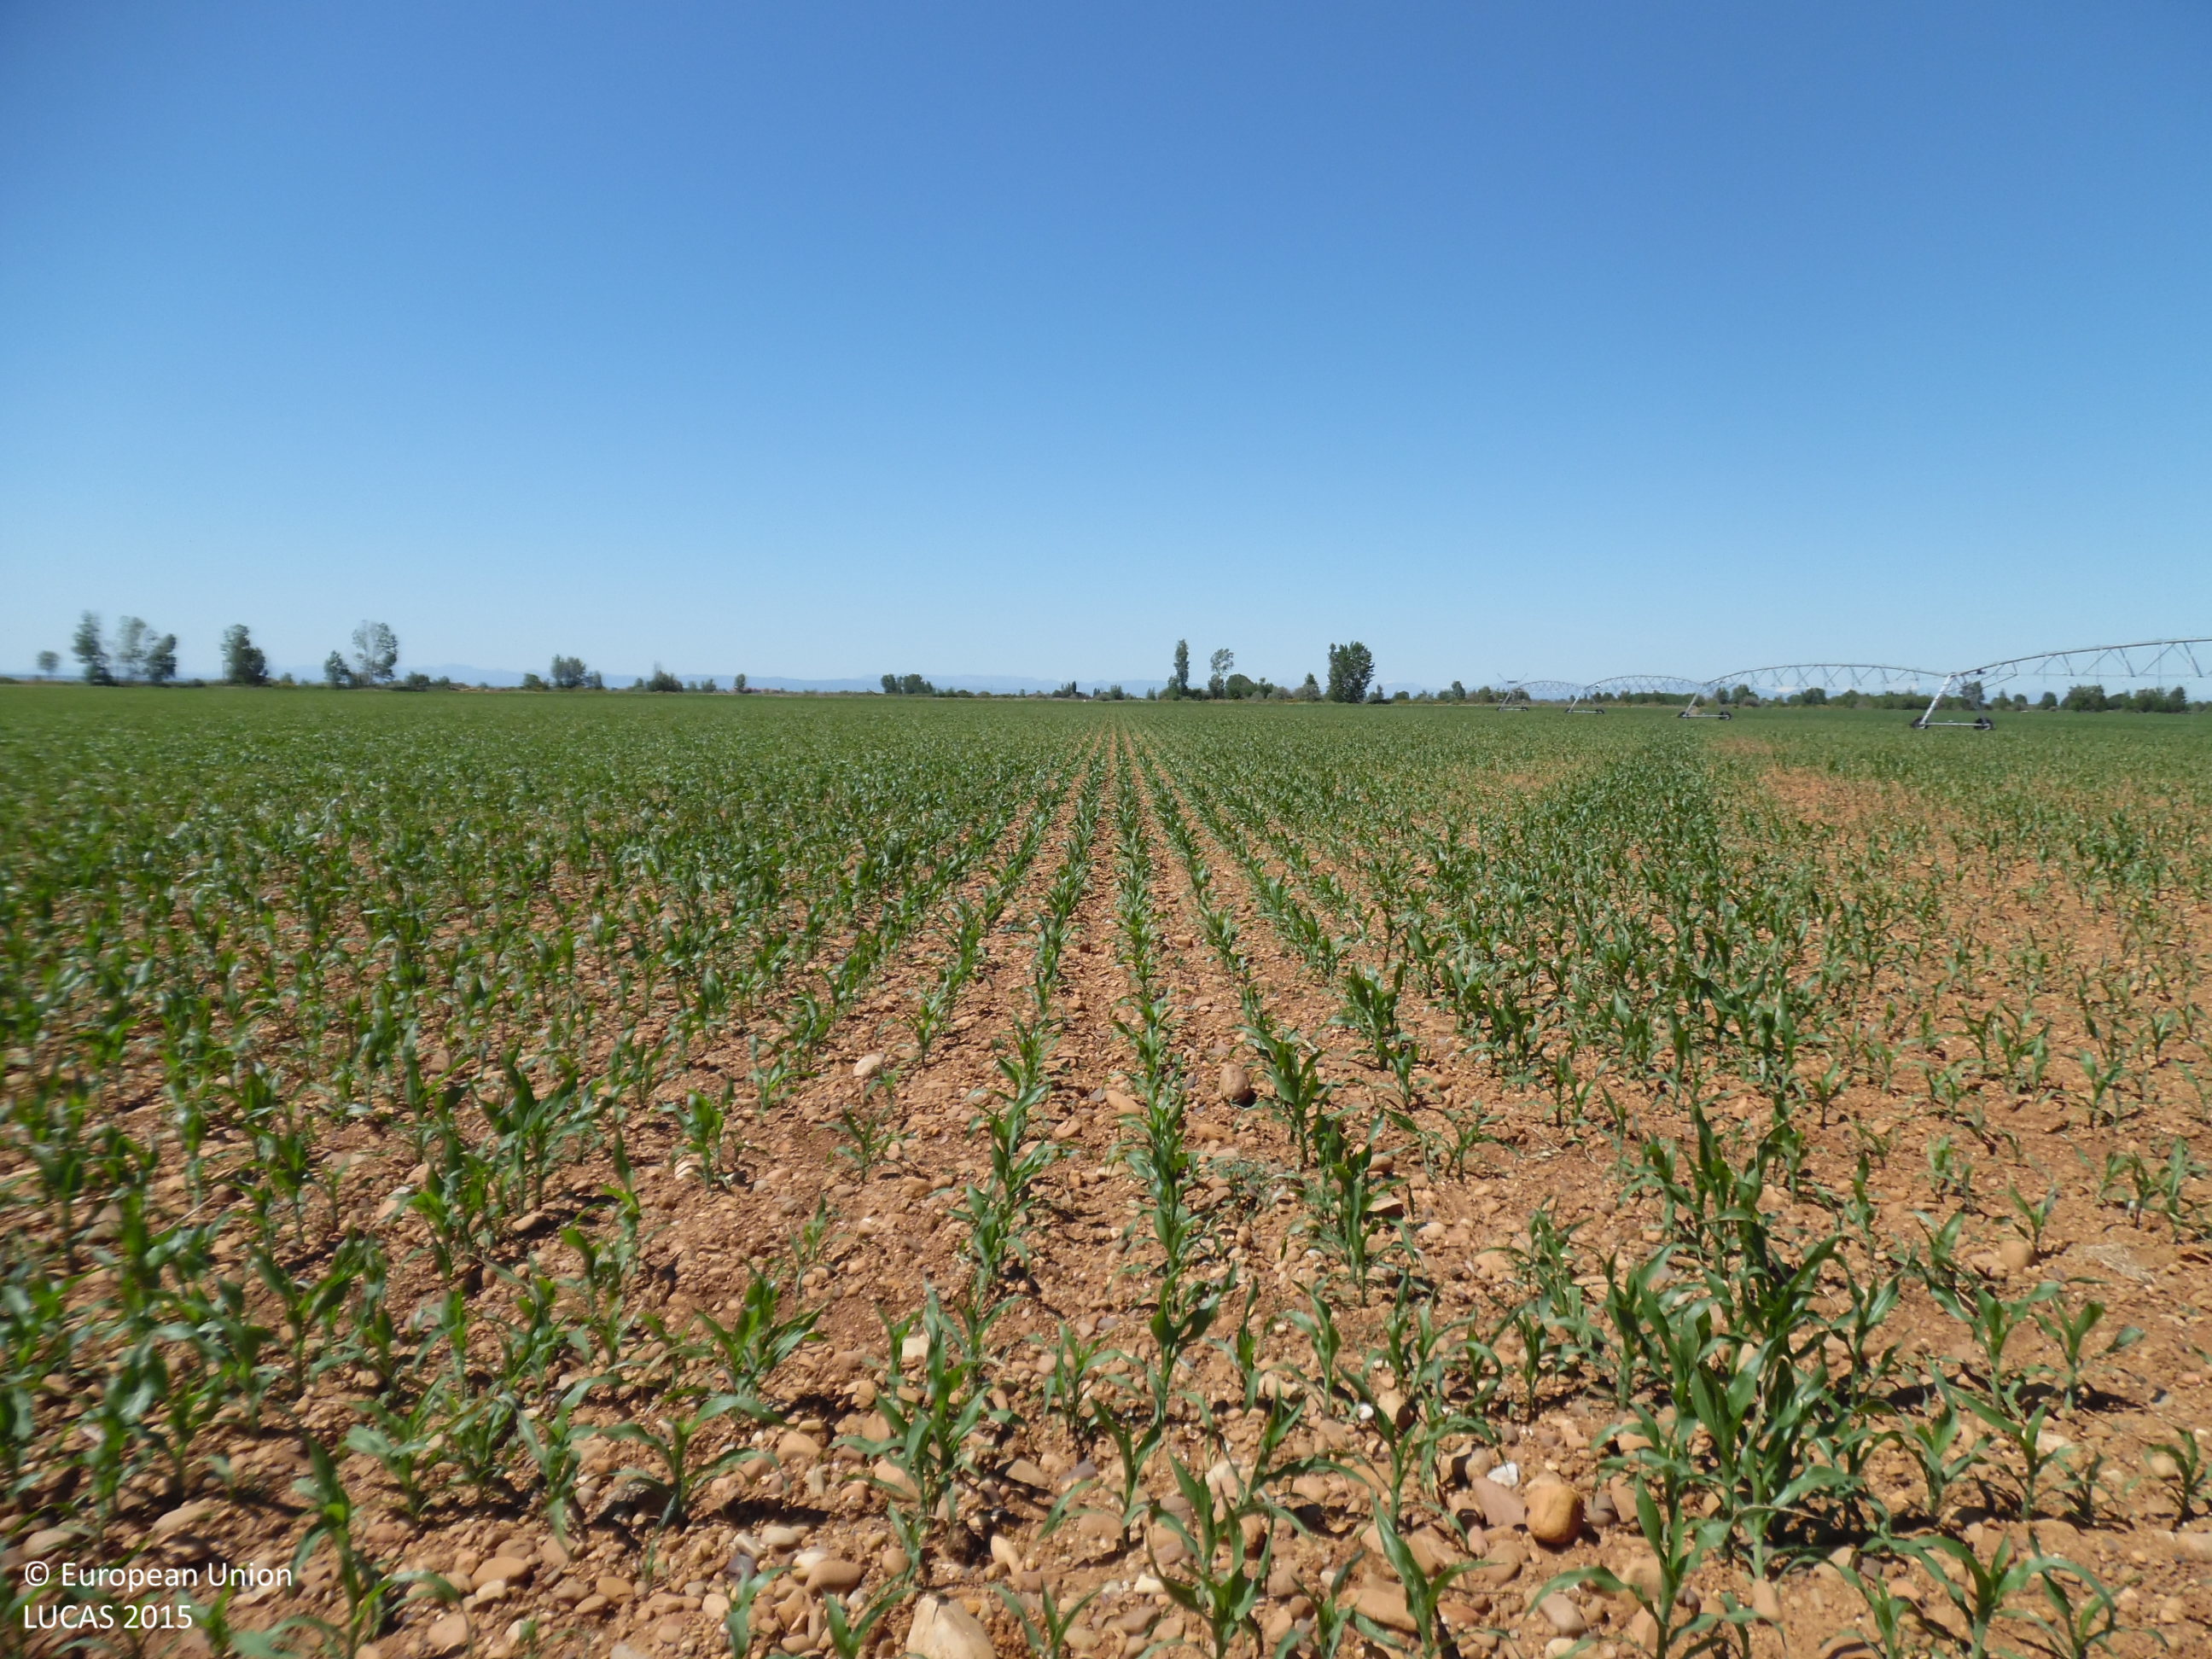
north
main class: Cropland
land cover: Maize
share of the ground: 50 - 75 %
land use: Agriculture (excluding fallow land and kitchen gardens)
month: June
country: ES
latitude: 42.4029
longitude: -5.7597
